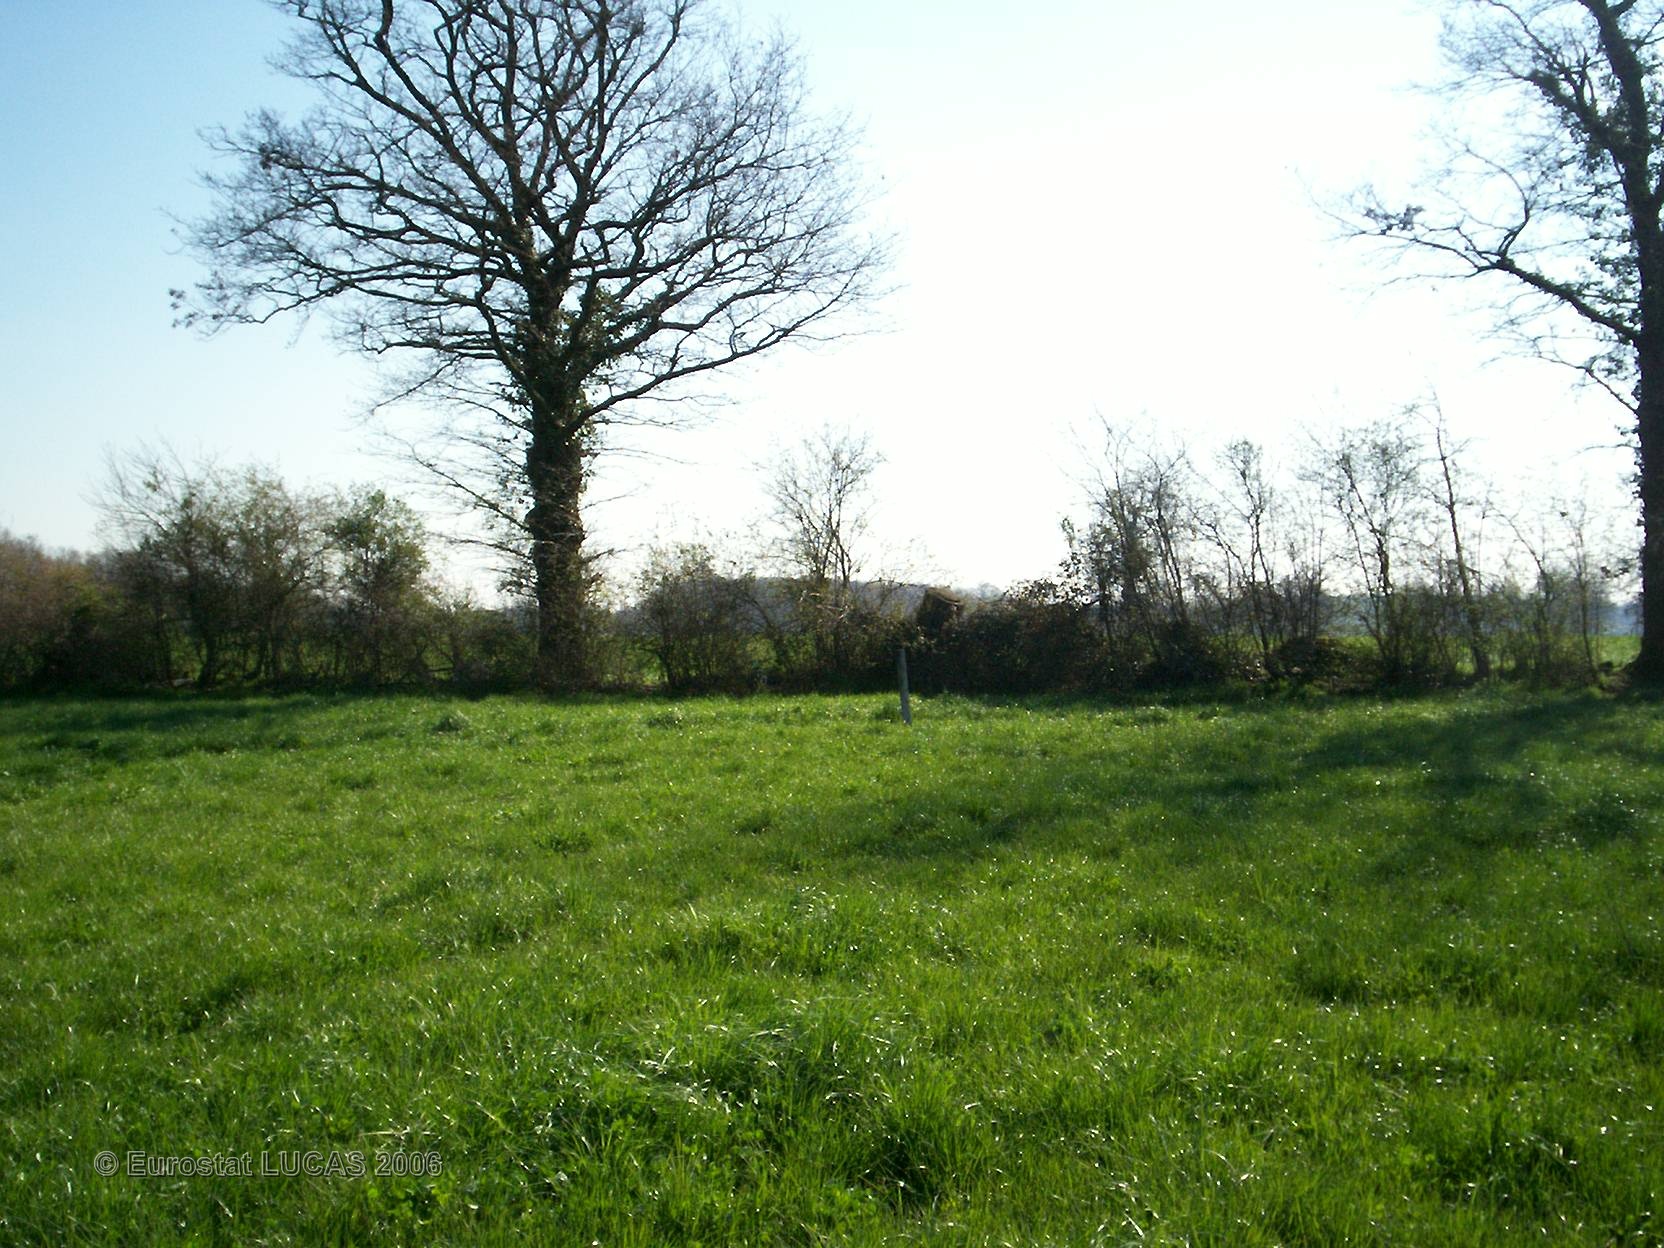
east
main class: Grassland
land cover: Grassland without tree/shrub cover
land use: Agriculture (excluding fallow land and kitchen gardens)
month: April
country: FR
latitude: 46.3588
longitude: 1.0848
